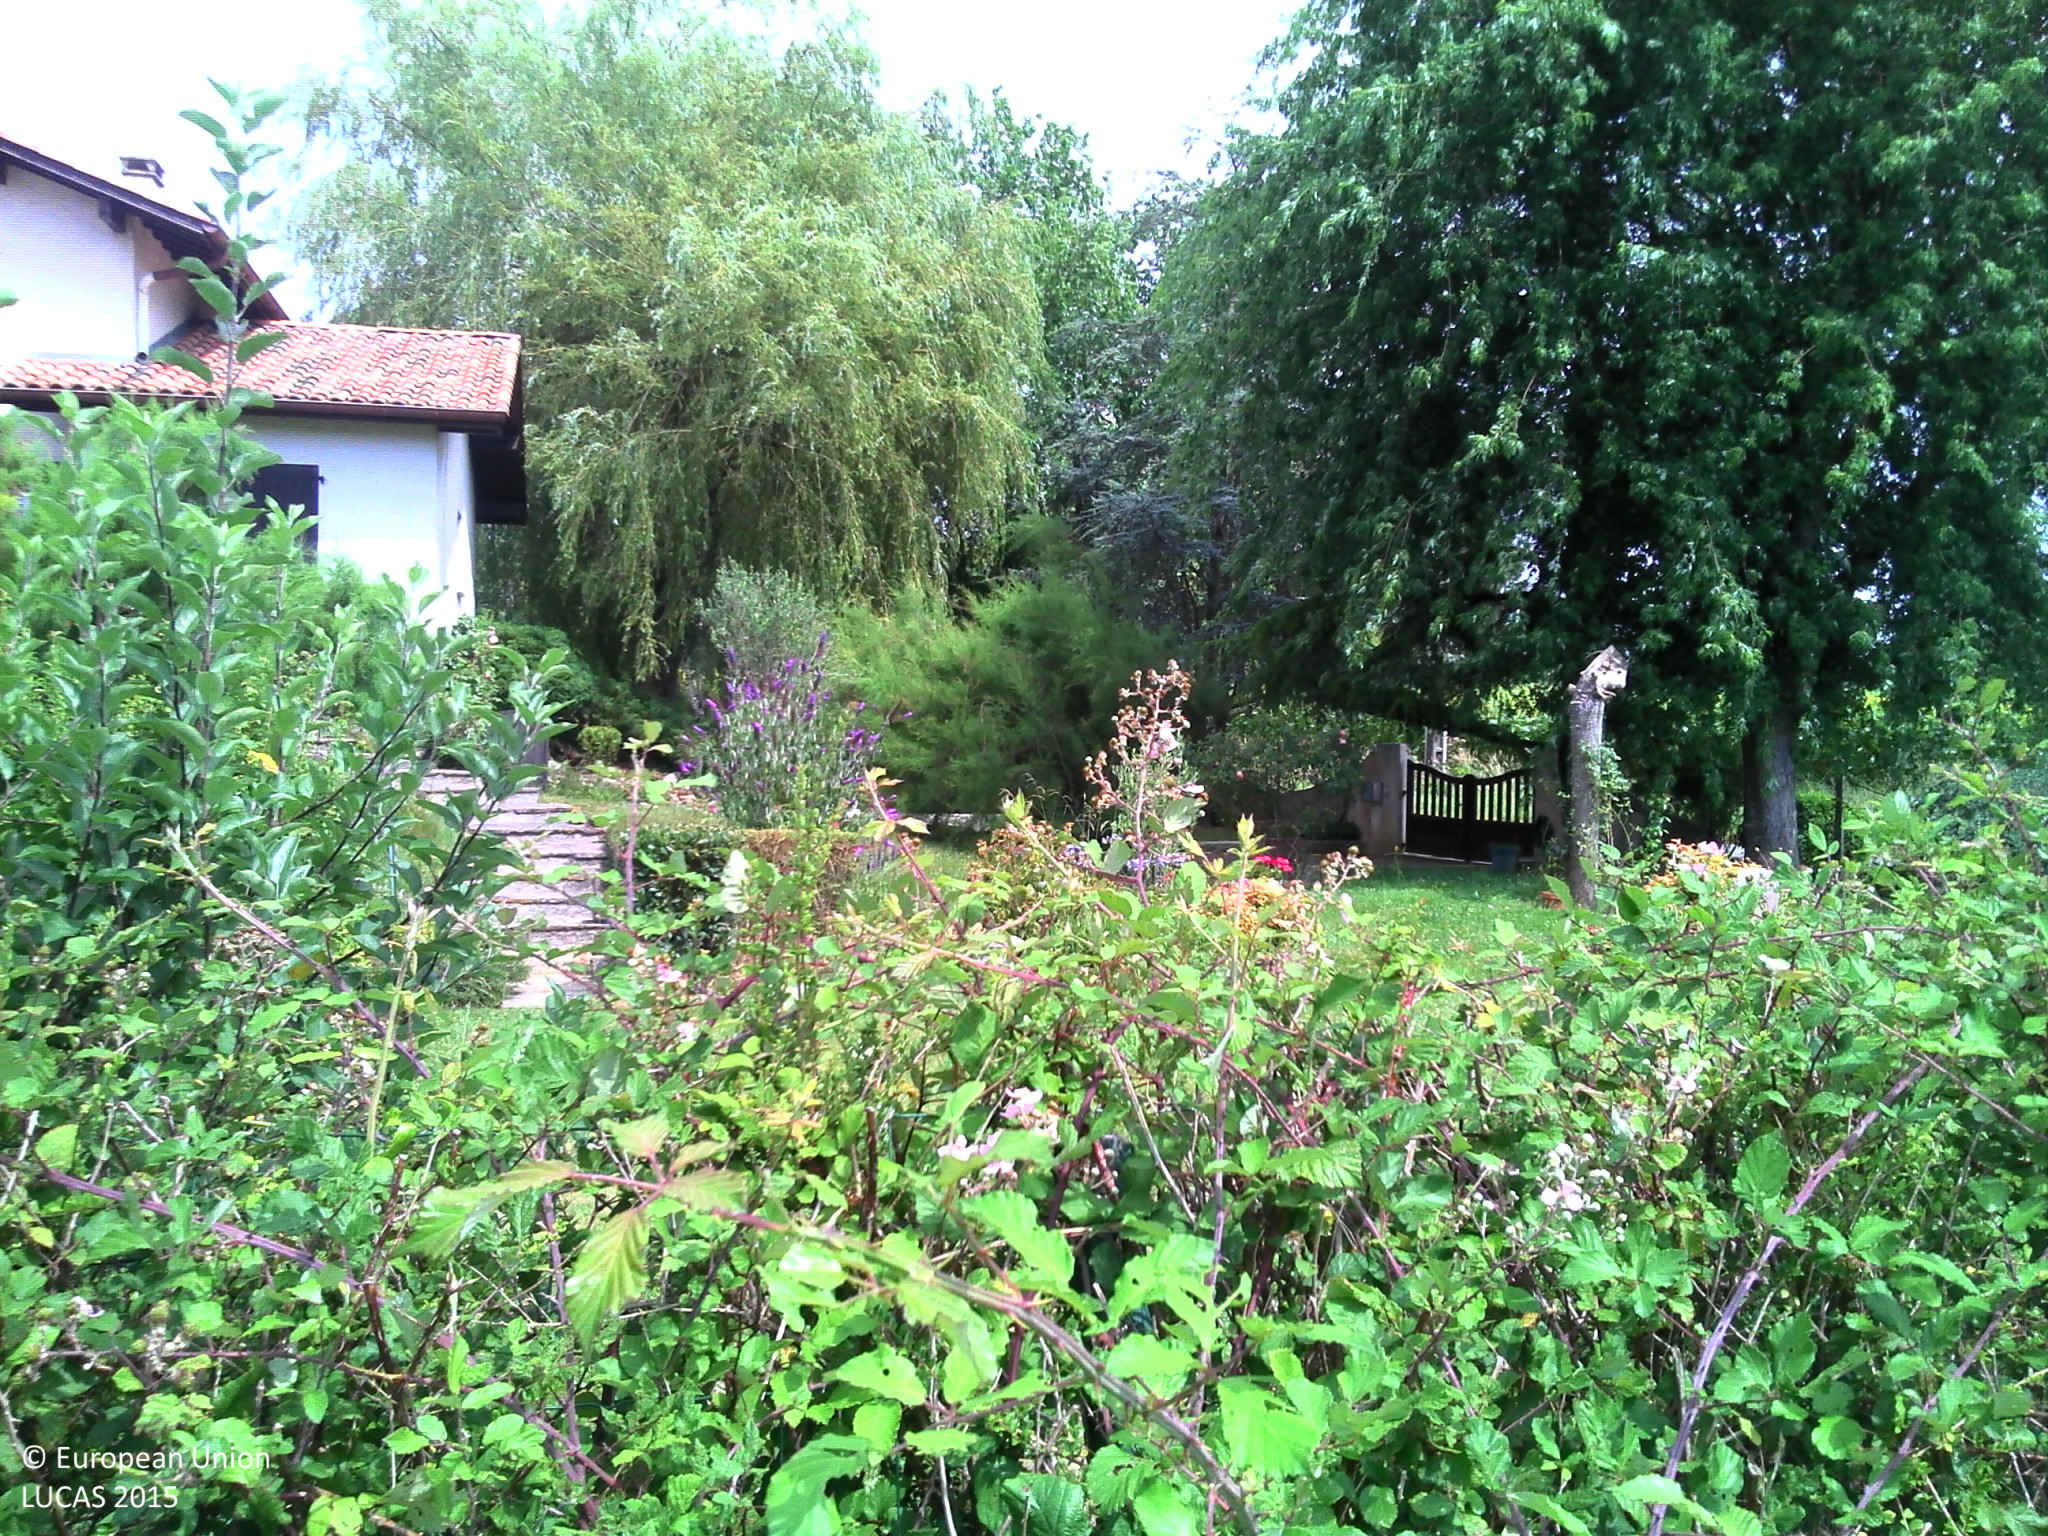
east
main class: Grassland
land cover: Grassland without tree/shrub cover
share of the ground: > 75 %
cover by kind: herbaceous plants 100 %
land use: Residential
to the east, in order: Grassland without tree/shrub cover; Artificial constructions in urban areas; Maize
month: July
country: FR
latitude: 43.5857
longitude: -1.3000
